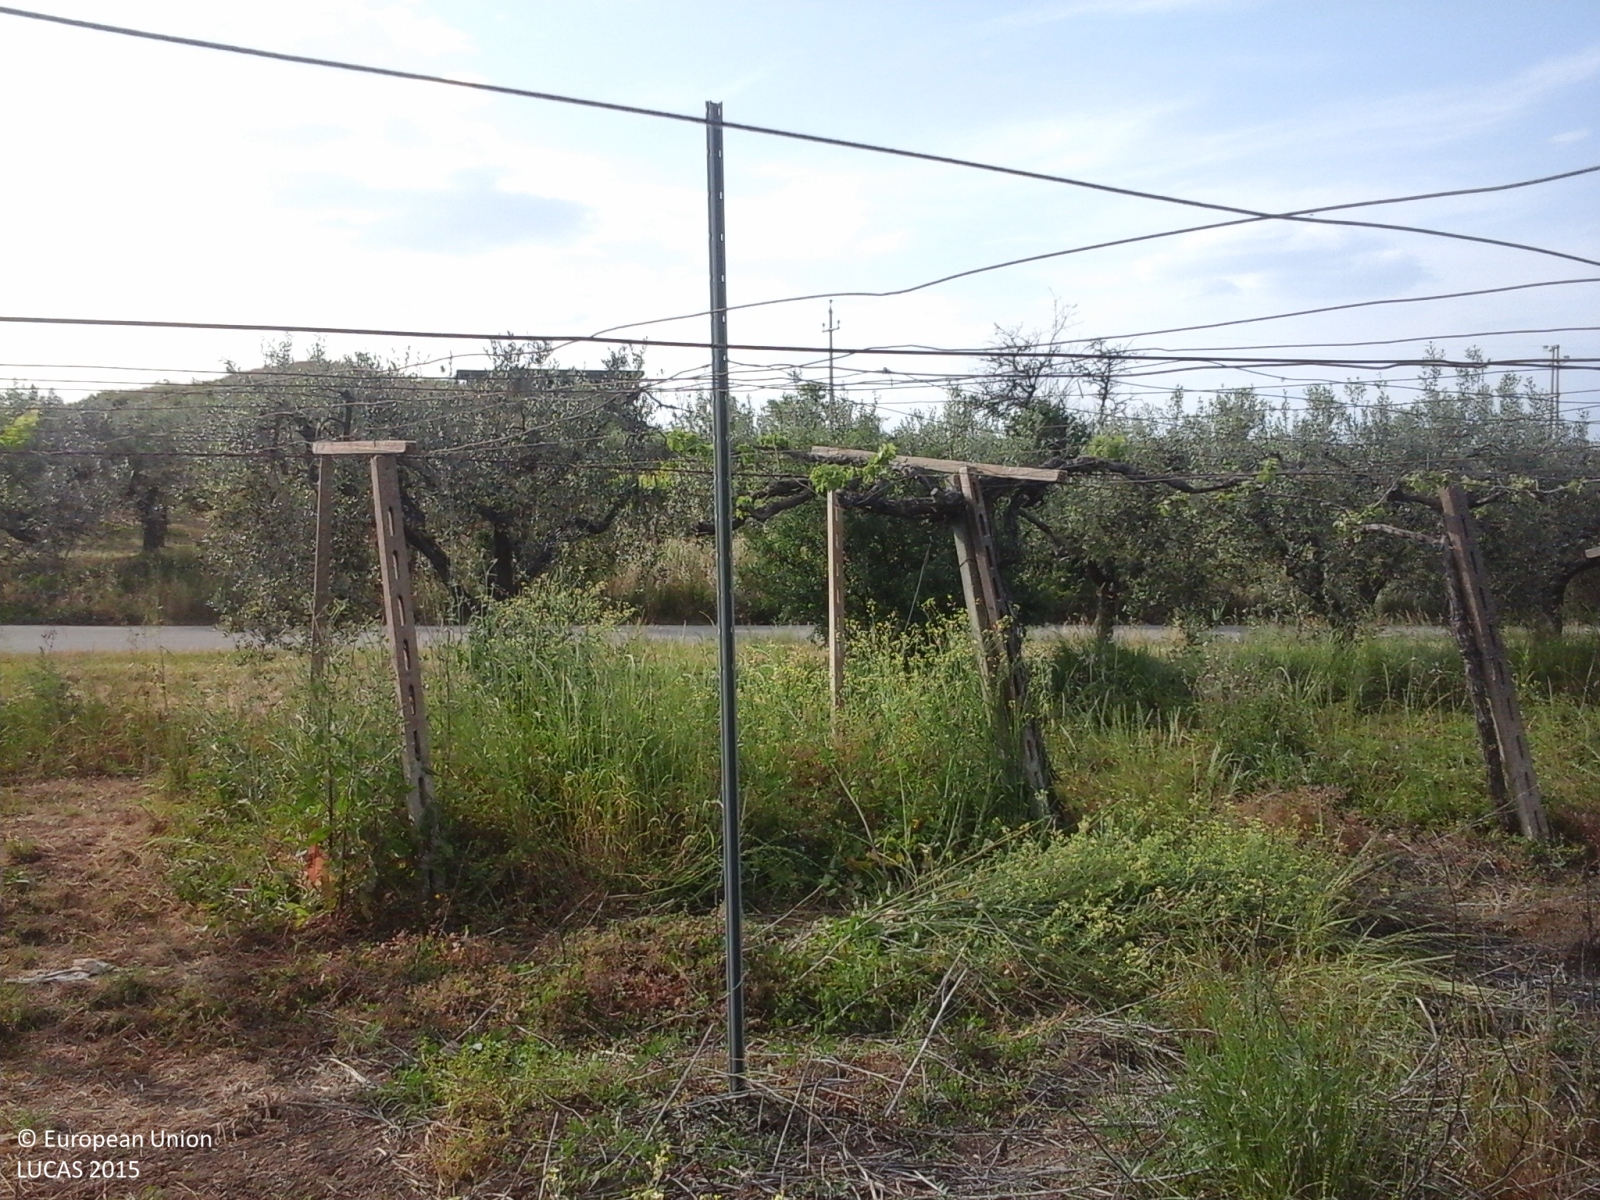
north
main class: Cropland
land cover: Vineyards
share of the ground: < 10 %
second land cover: Spontaneously vegetated surfaces
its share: > 75 %
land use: Abandoned areas
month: May
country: IT
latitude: 42.1867
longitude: 14.6235
